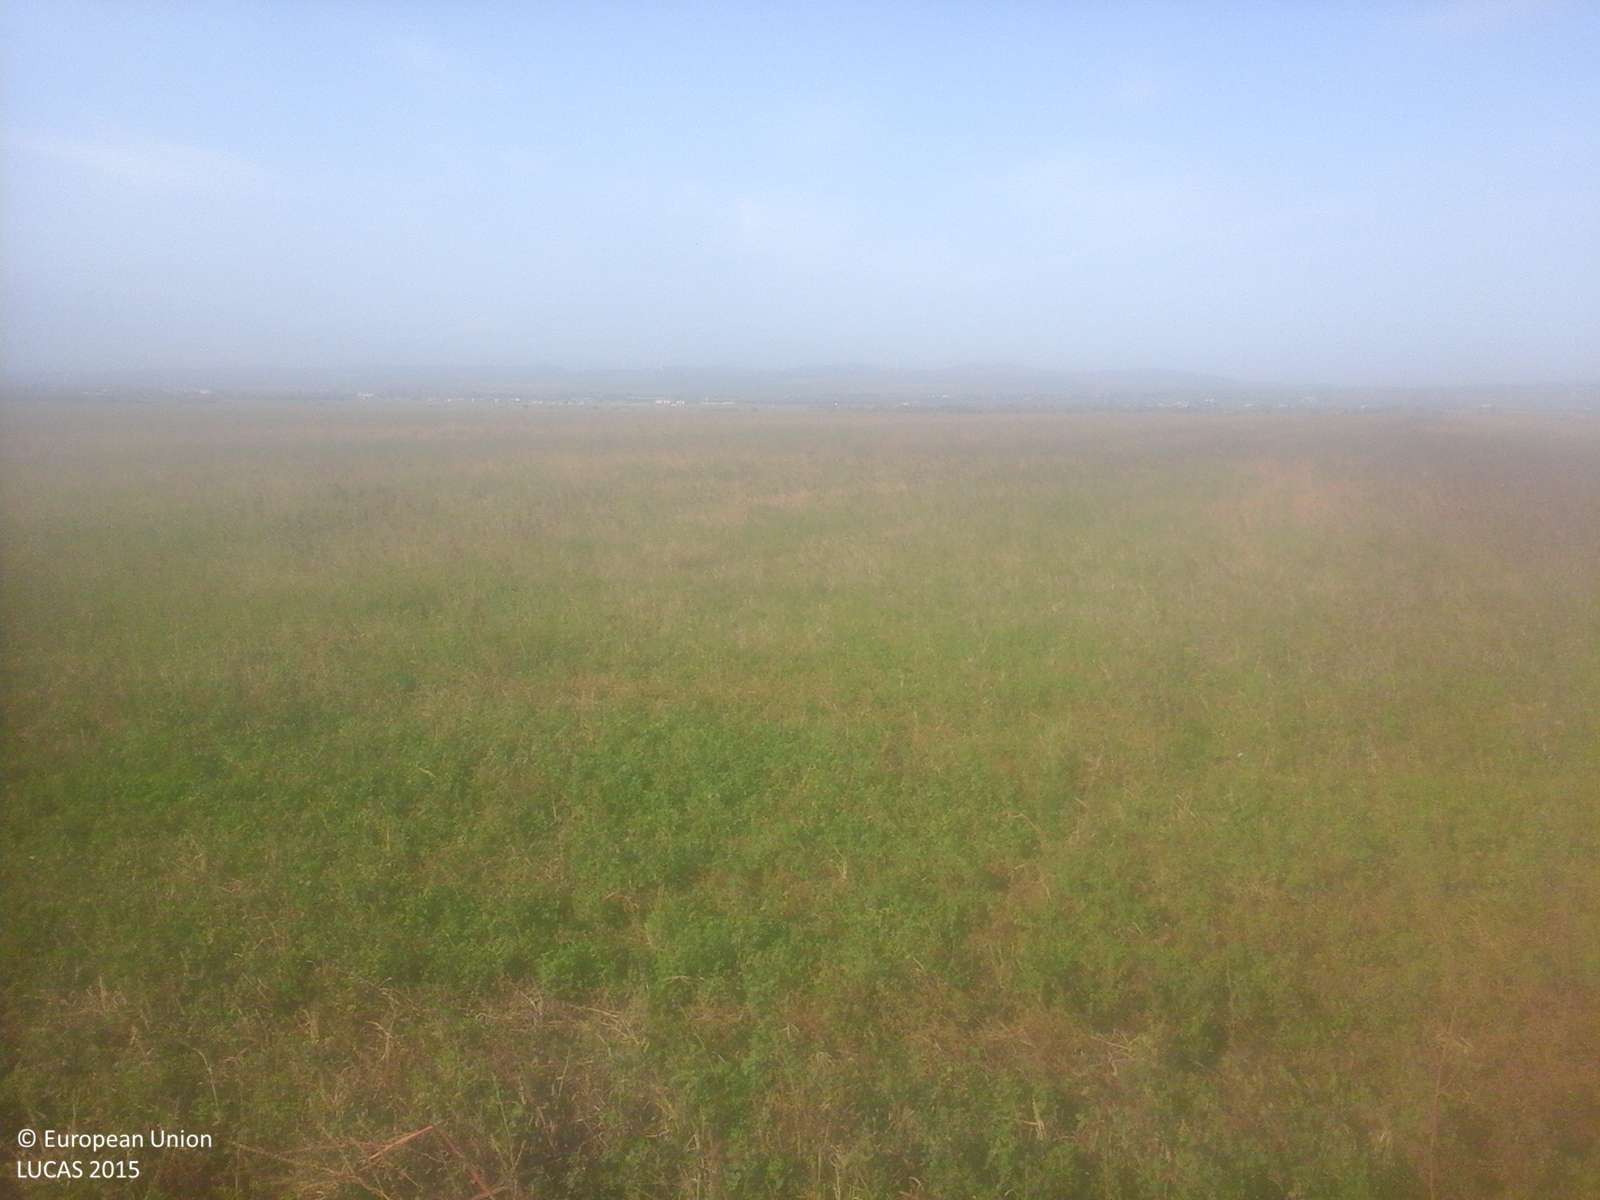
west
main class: Grassland
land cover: Spontaneously vegetated surfaces
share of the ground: > 75 %
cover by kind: herbaceous plants 100 %
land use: Agriculture (excluding fallow land and kitchen gardens)
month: October
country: RO
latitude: 45.4034
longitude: 27.0943
